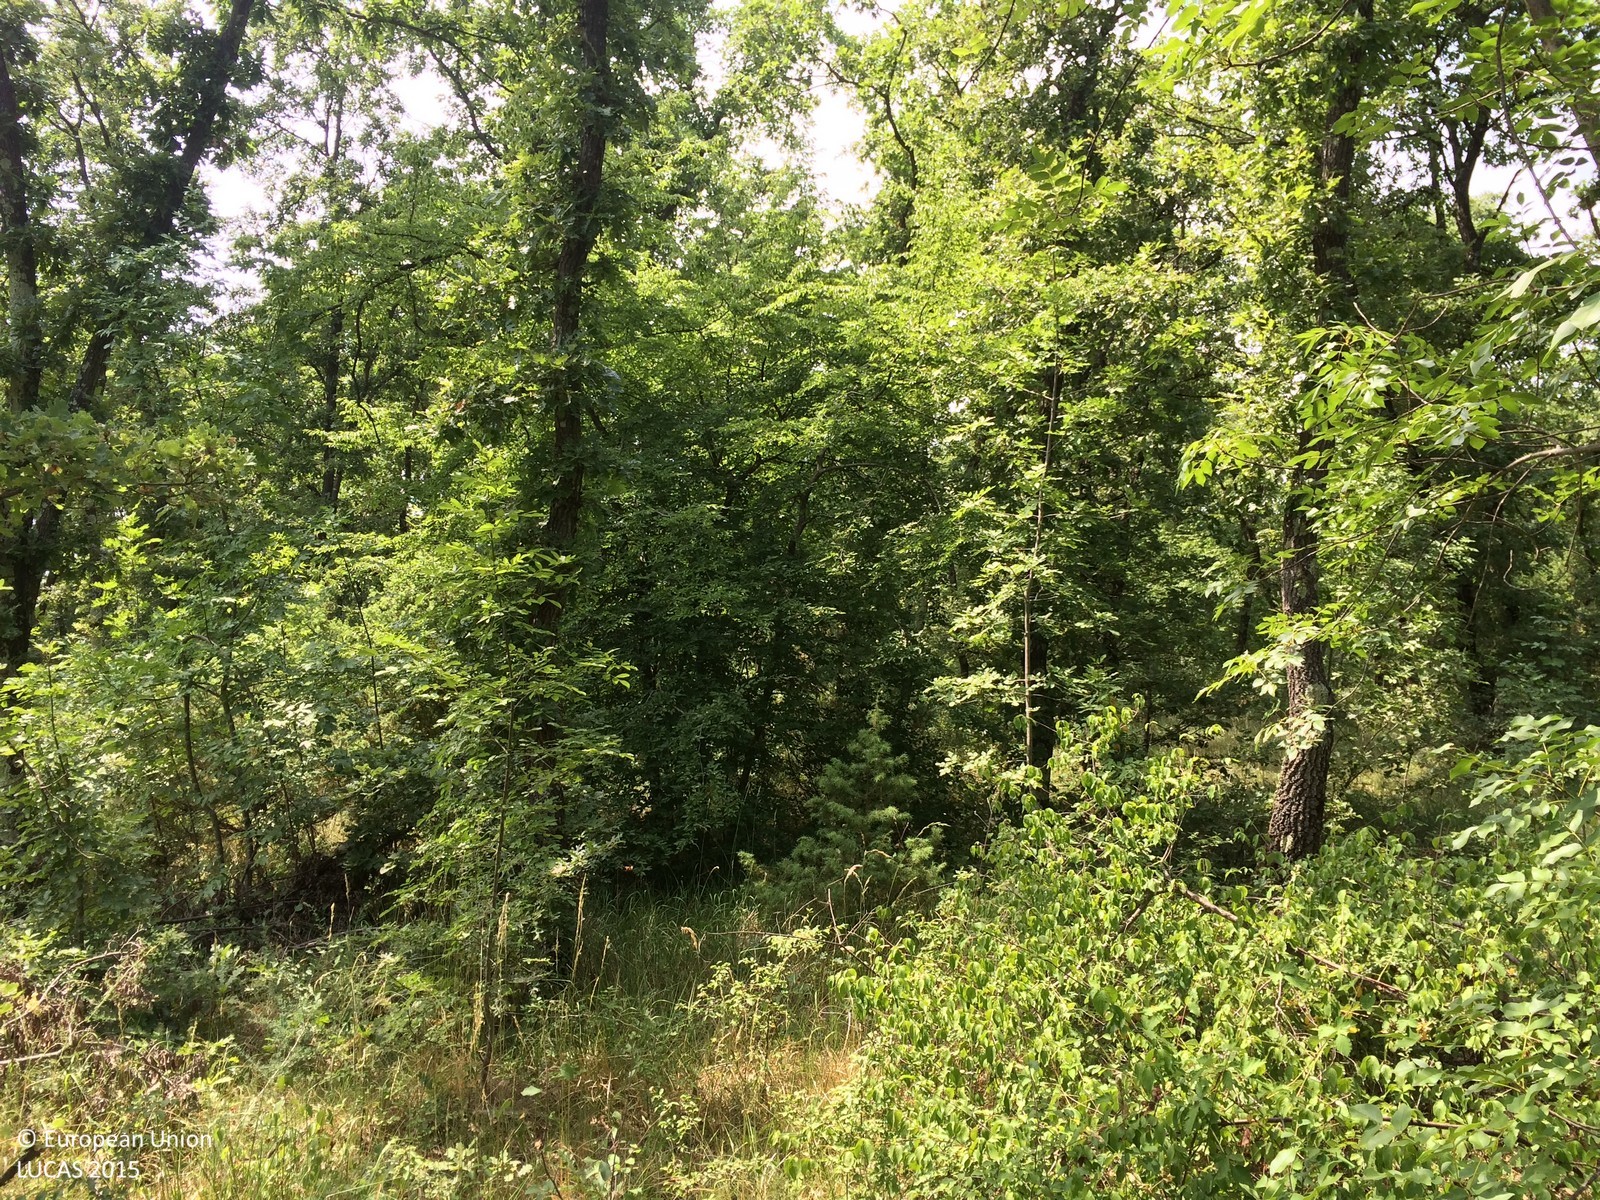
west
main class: Woodland
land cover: Broadleaved woodland
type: mesophytic deciduous forest
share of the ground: > 75 %
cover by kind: broadleaved forest trees 90 %, shrubs 5 %, herbaceous plants 5 %
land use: Semi-natural and natural areas not in use
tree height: > 5 m
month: June
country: HR
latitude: 45.0727
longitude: 13.8686
